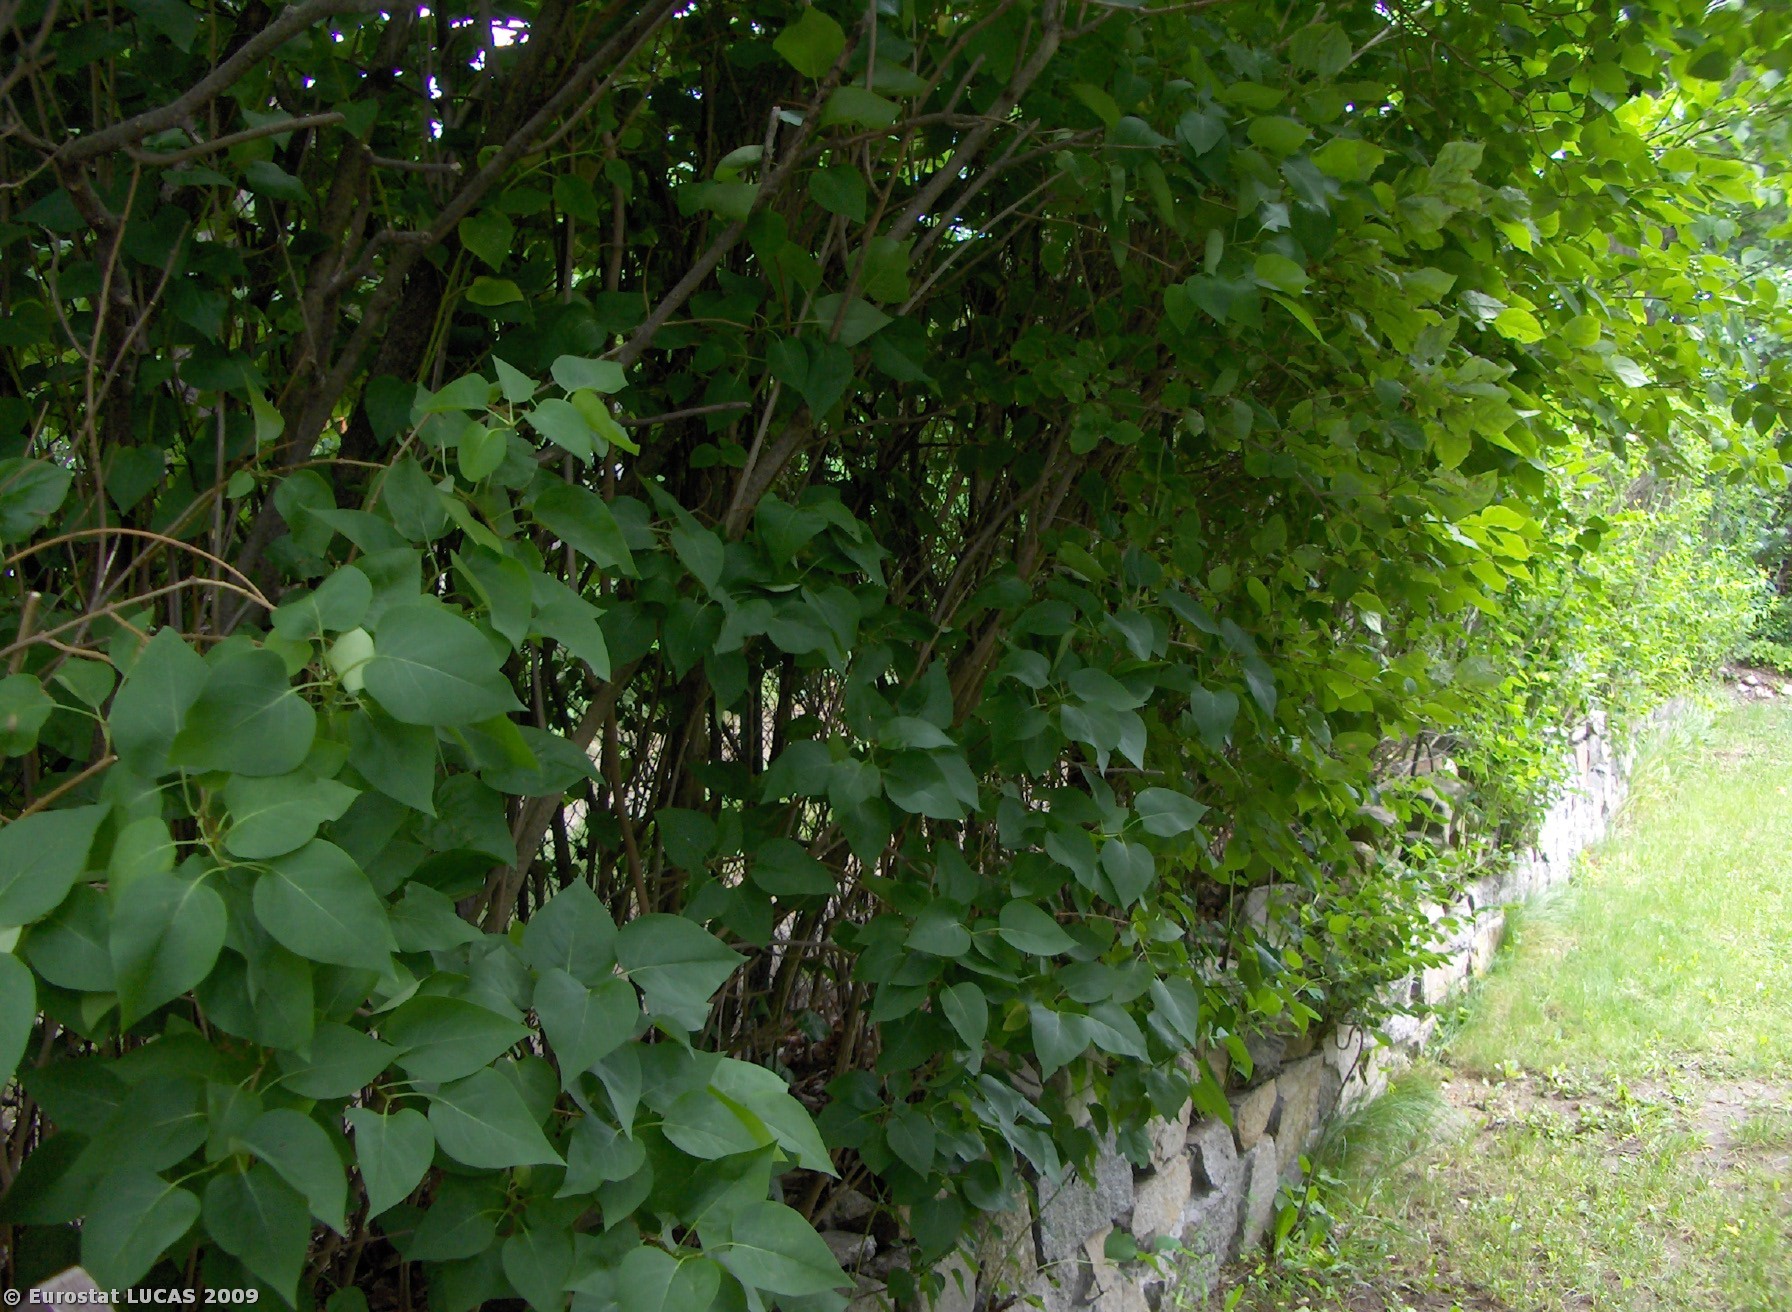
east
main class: Cropland
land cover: Apple fruit
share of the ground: 50 - 75 %
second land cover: Grassland with sparse tree/shrub cover
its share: > 75 %
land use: Kitchen garden
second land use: Amenities, museums, leisure
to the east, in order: Apple fruit; Grassland with sparse tree/shrub cover; Artificial constructions in urban areas; Fences; Grass margins; Tracks; Rye
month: June
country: CZ
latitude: 49.0042
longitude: 14.3069
